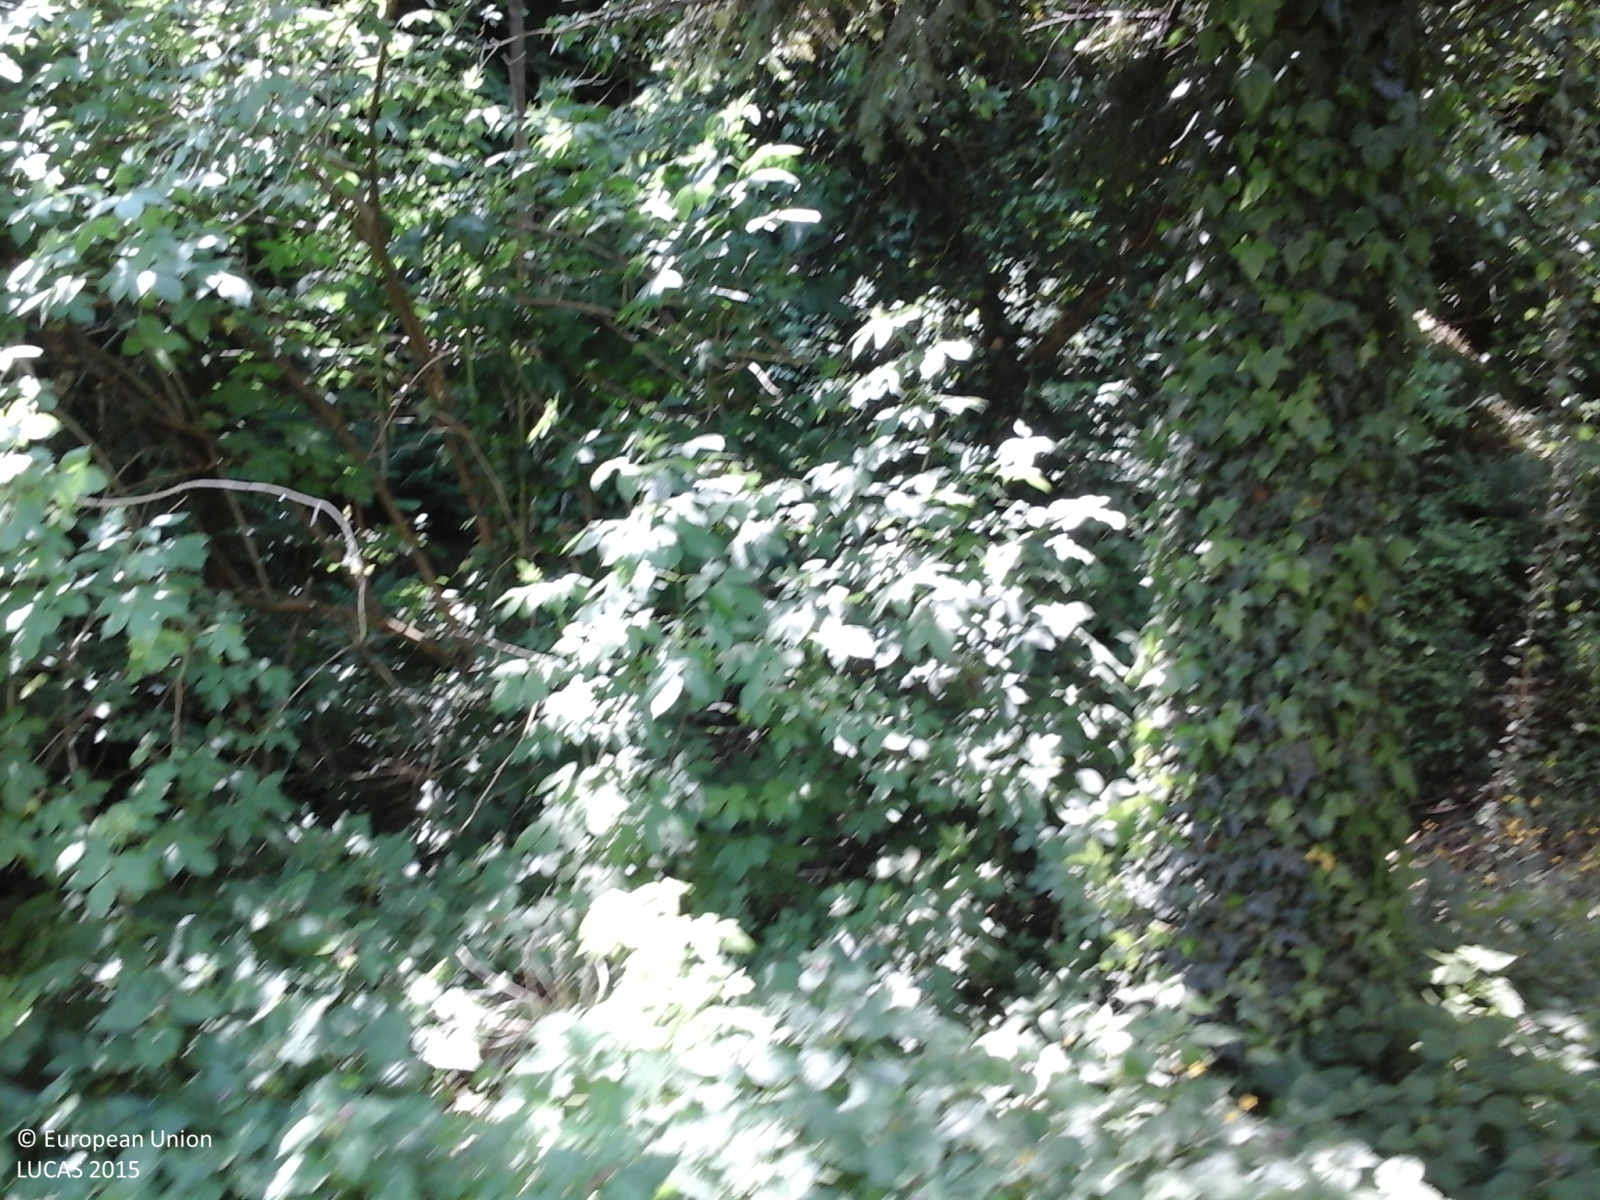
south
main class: Woodland
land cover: Broadleaved woodland
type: thermophilous deciduous forest
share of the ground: > 75 %
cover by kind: broadleaved forest trees 100 %
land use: Semi-natural and natural areas not in use
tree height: > 5 m
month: May
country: IT
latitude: 45.3102
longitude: 11.7189
